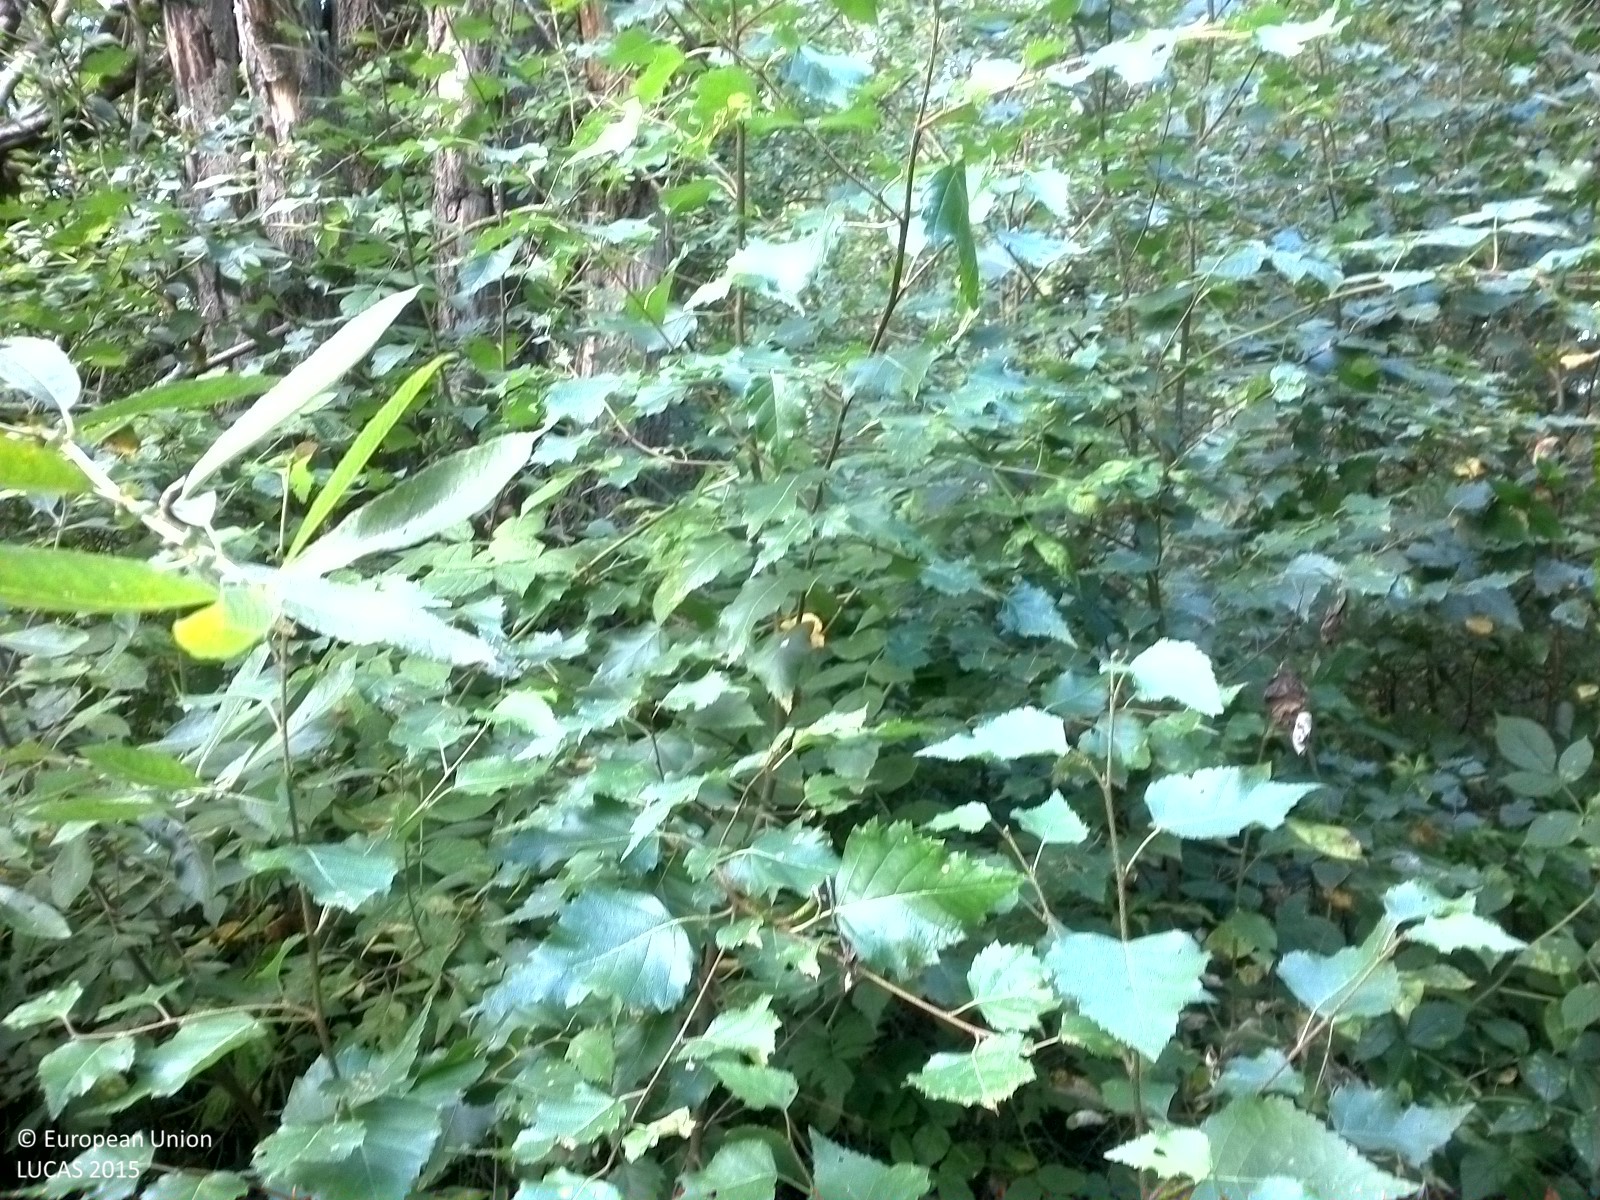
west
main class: Woodland
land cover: Broadleaved woodland
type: hemiboreal forest and nemoral coniferous forest and mixed broadleaved-coniferous forest
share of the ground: 50 - 75 %
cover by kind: broadleaved forest trees 60 %, herbaceous plants 20 %, shrubs 10 %, consolidated bare surface 10 %
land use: Semi-natural and natural areas not in use
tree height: > 5 m
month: September
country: SE
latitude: 58.5996
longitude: 16.2071
